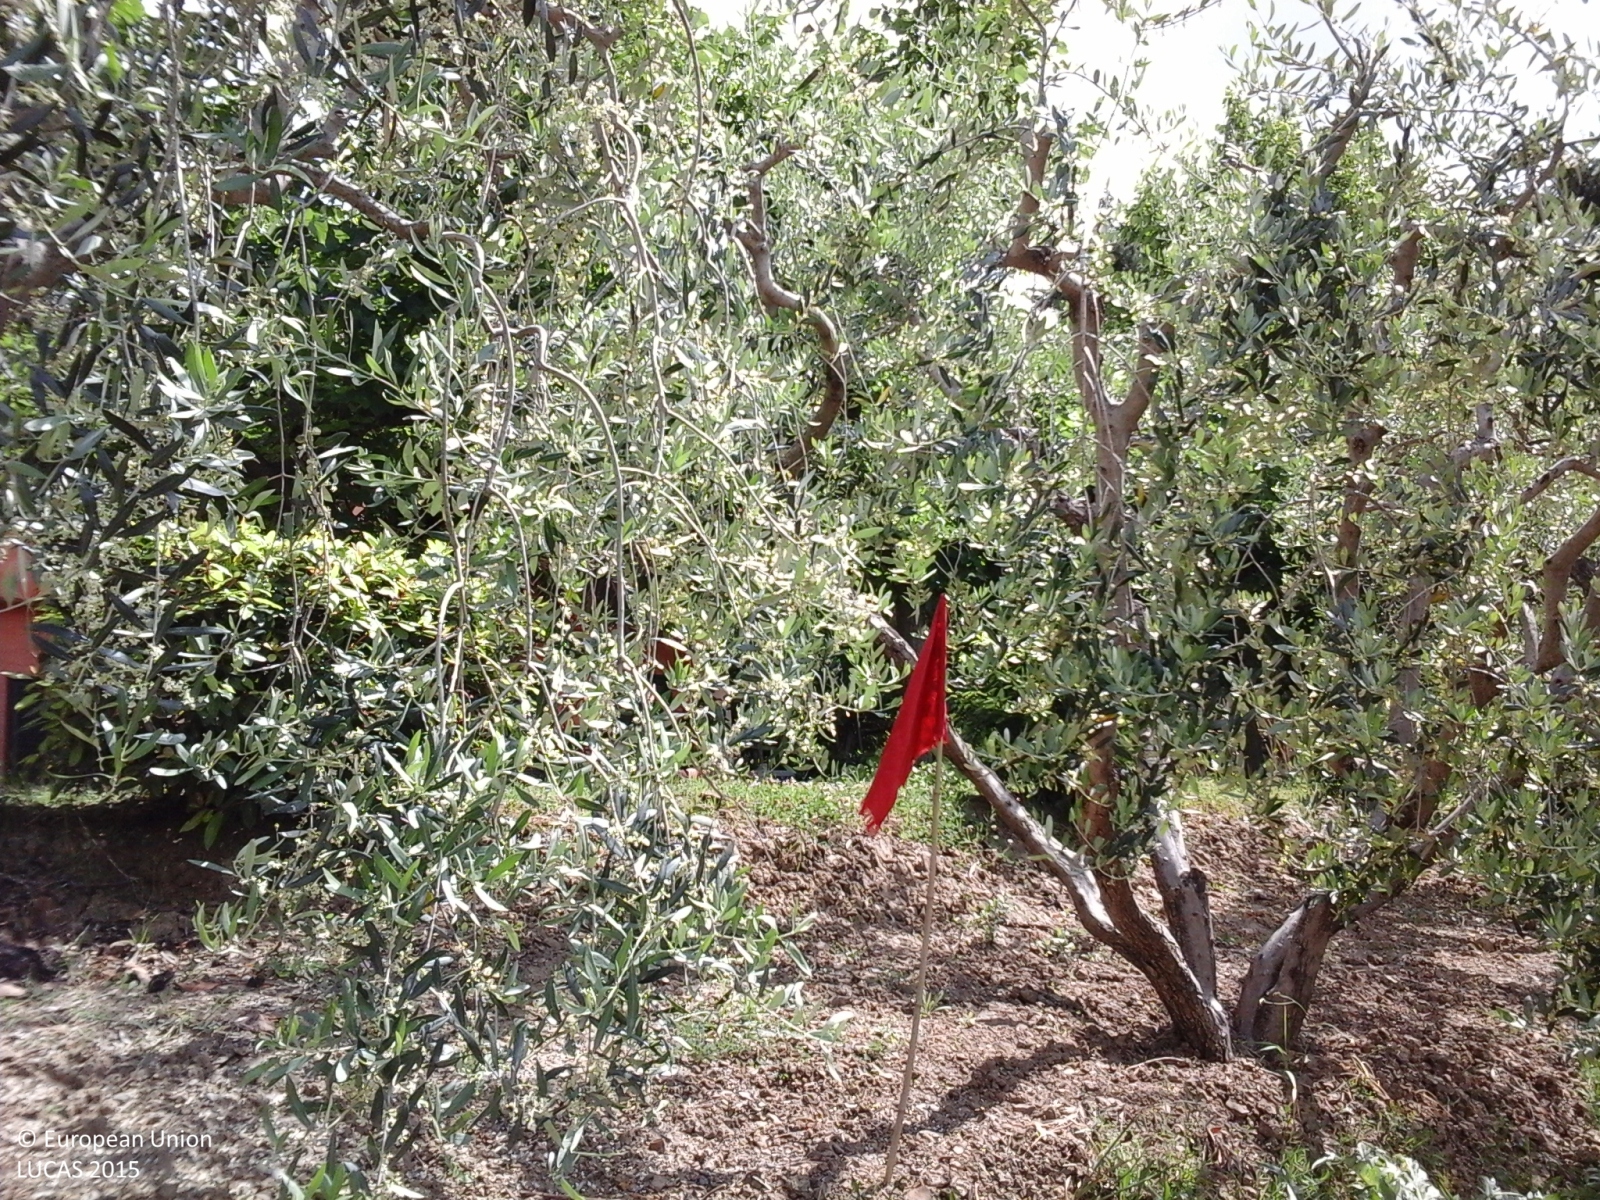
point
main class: Cropland
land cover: Olive groves
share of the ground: > 75 %
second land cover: Grassland without tree/shrub cover
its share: > 75 %
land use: Agriculture (excluding fallow land and kitchen gardens)
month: May
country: IT
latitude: 42.8603
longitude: 13.6248
